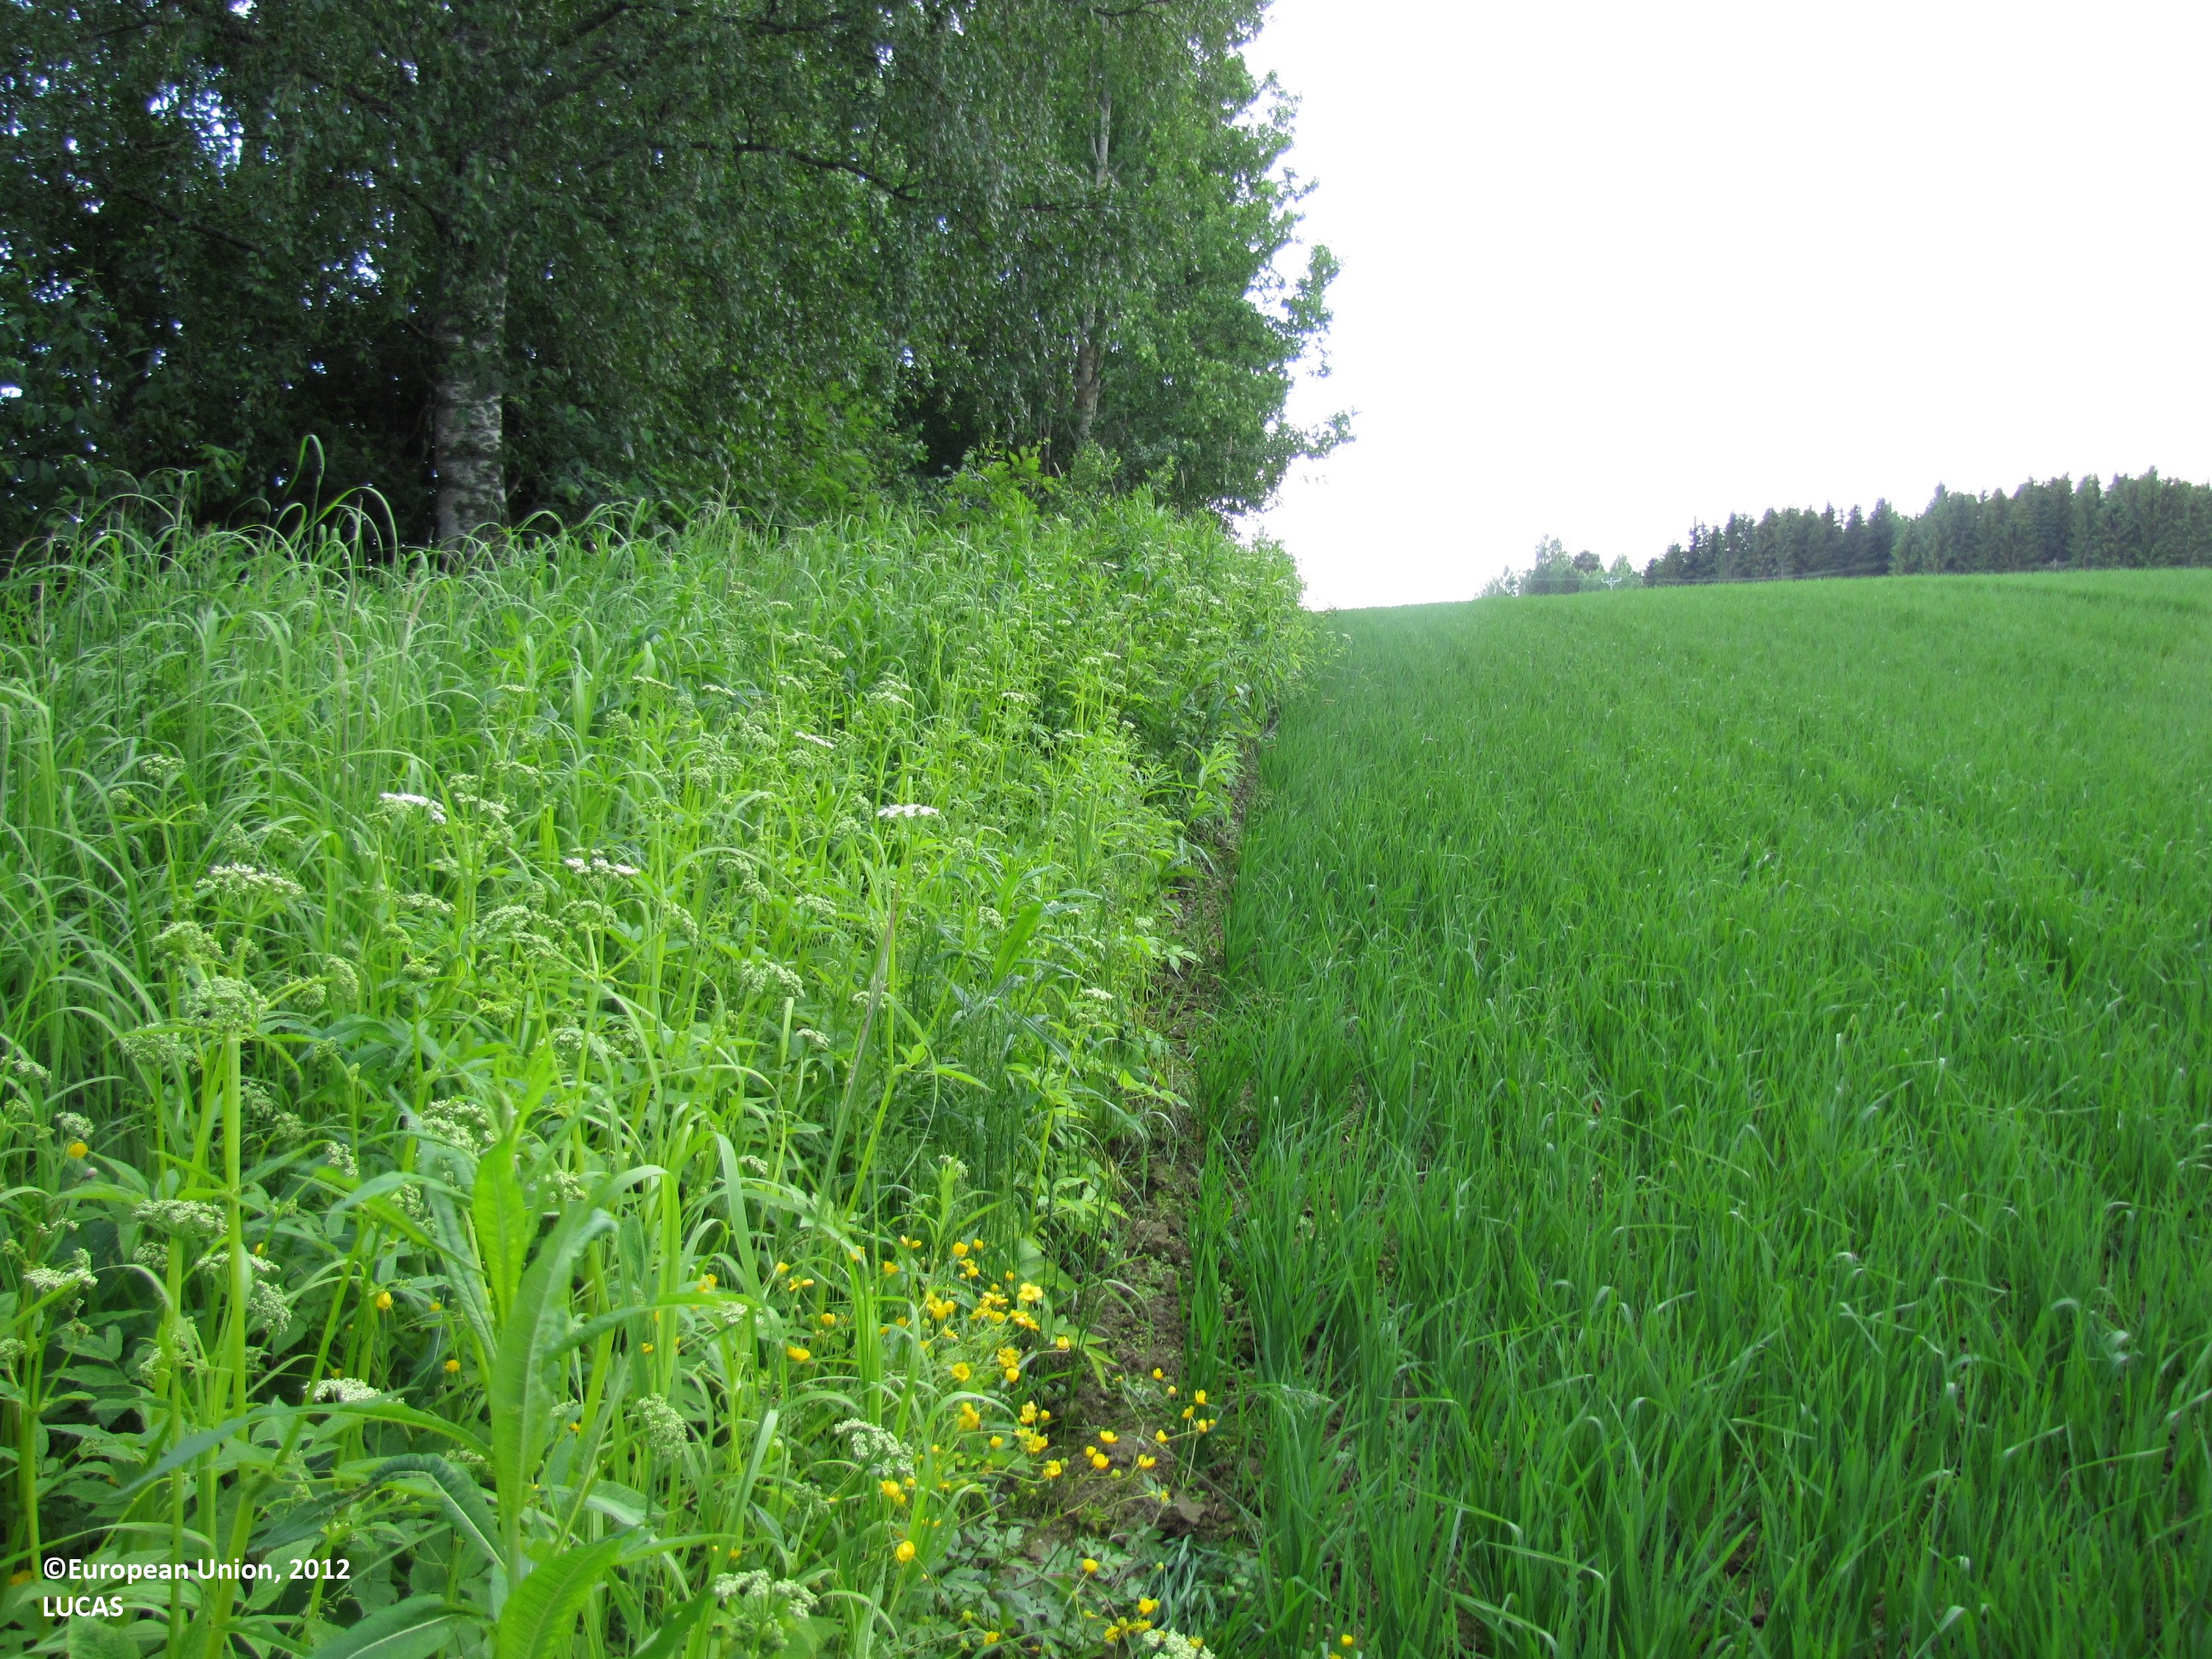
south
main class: Cropland
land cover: Oats
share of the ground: 50 - 75 %
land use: Agriculture (excluding fallow land and kitchen gardens)
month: June
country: FI
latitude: 61.6939
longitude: 24.4056
